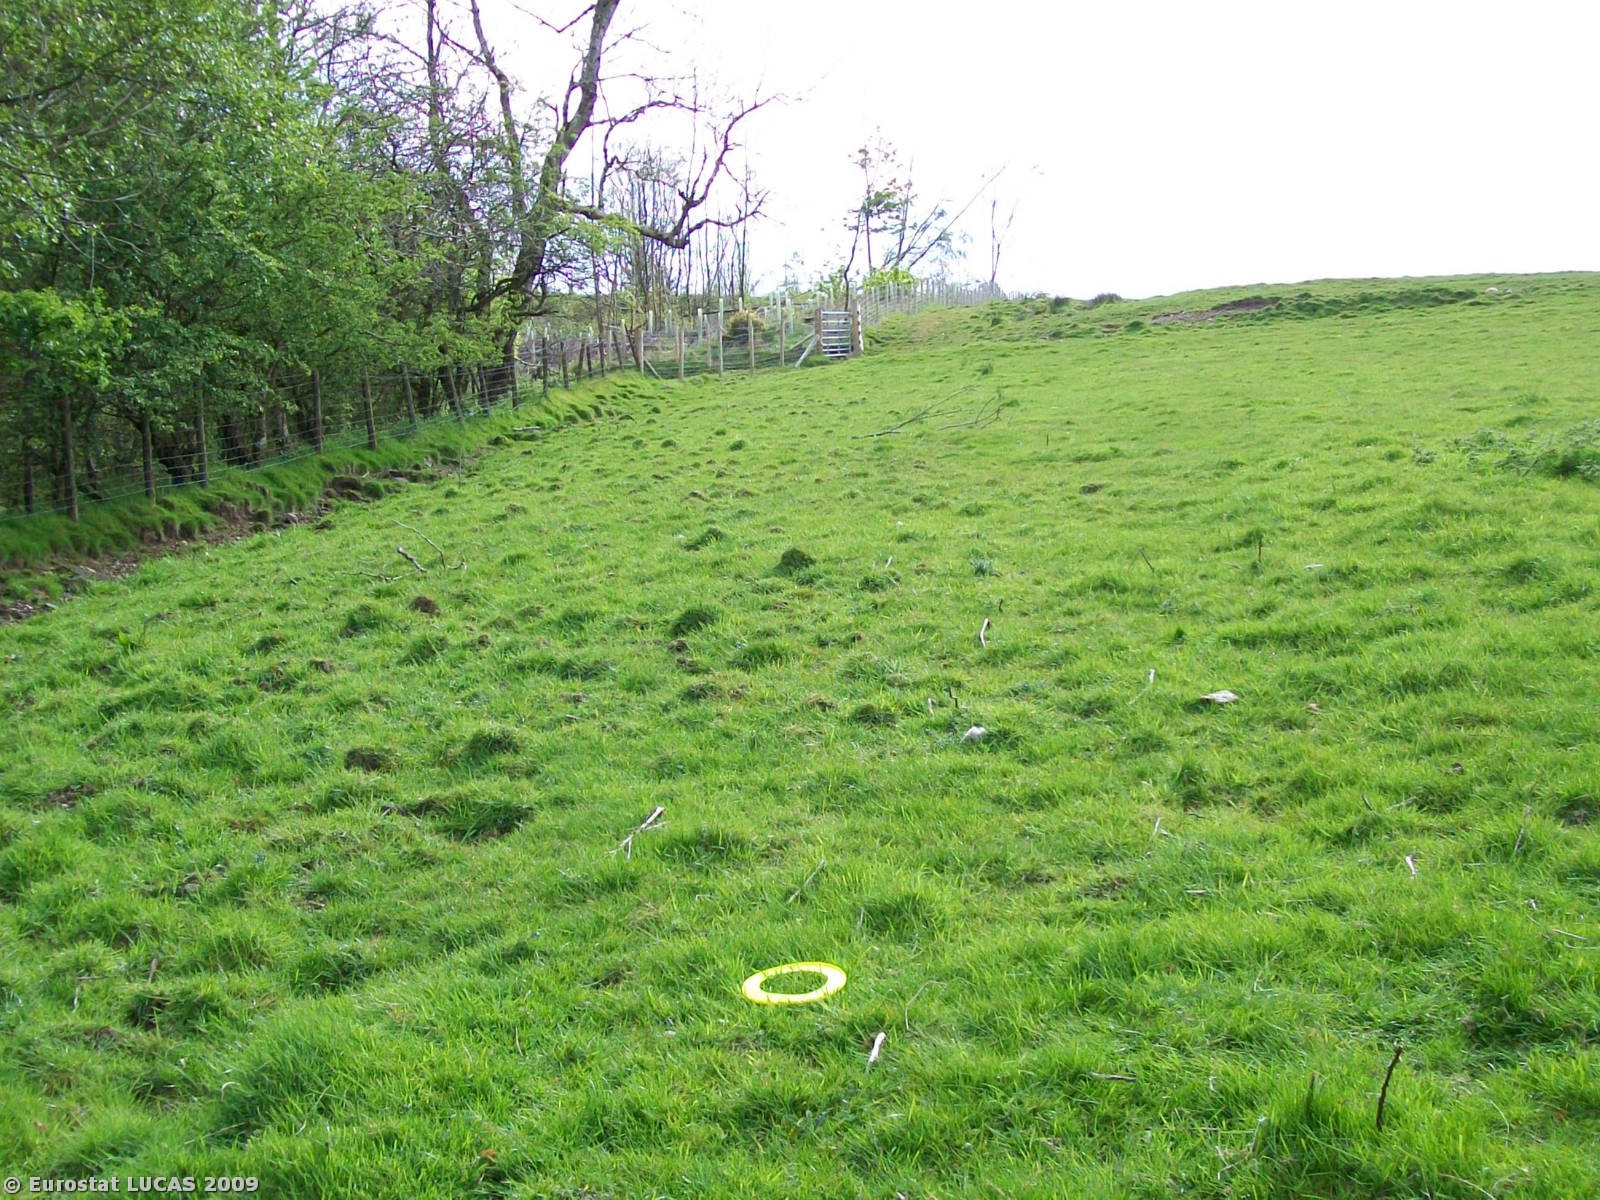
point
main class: Grassland
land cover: Grassland with sparse tree/shrub cover
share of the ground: > 75 %
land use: Agriculture (excluding fallow land and kitchen gardens)
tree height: > 5 m
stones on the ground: < 10 %
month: May
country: GB
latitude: 54.7181
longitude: -3.1935
